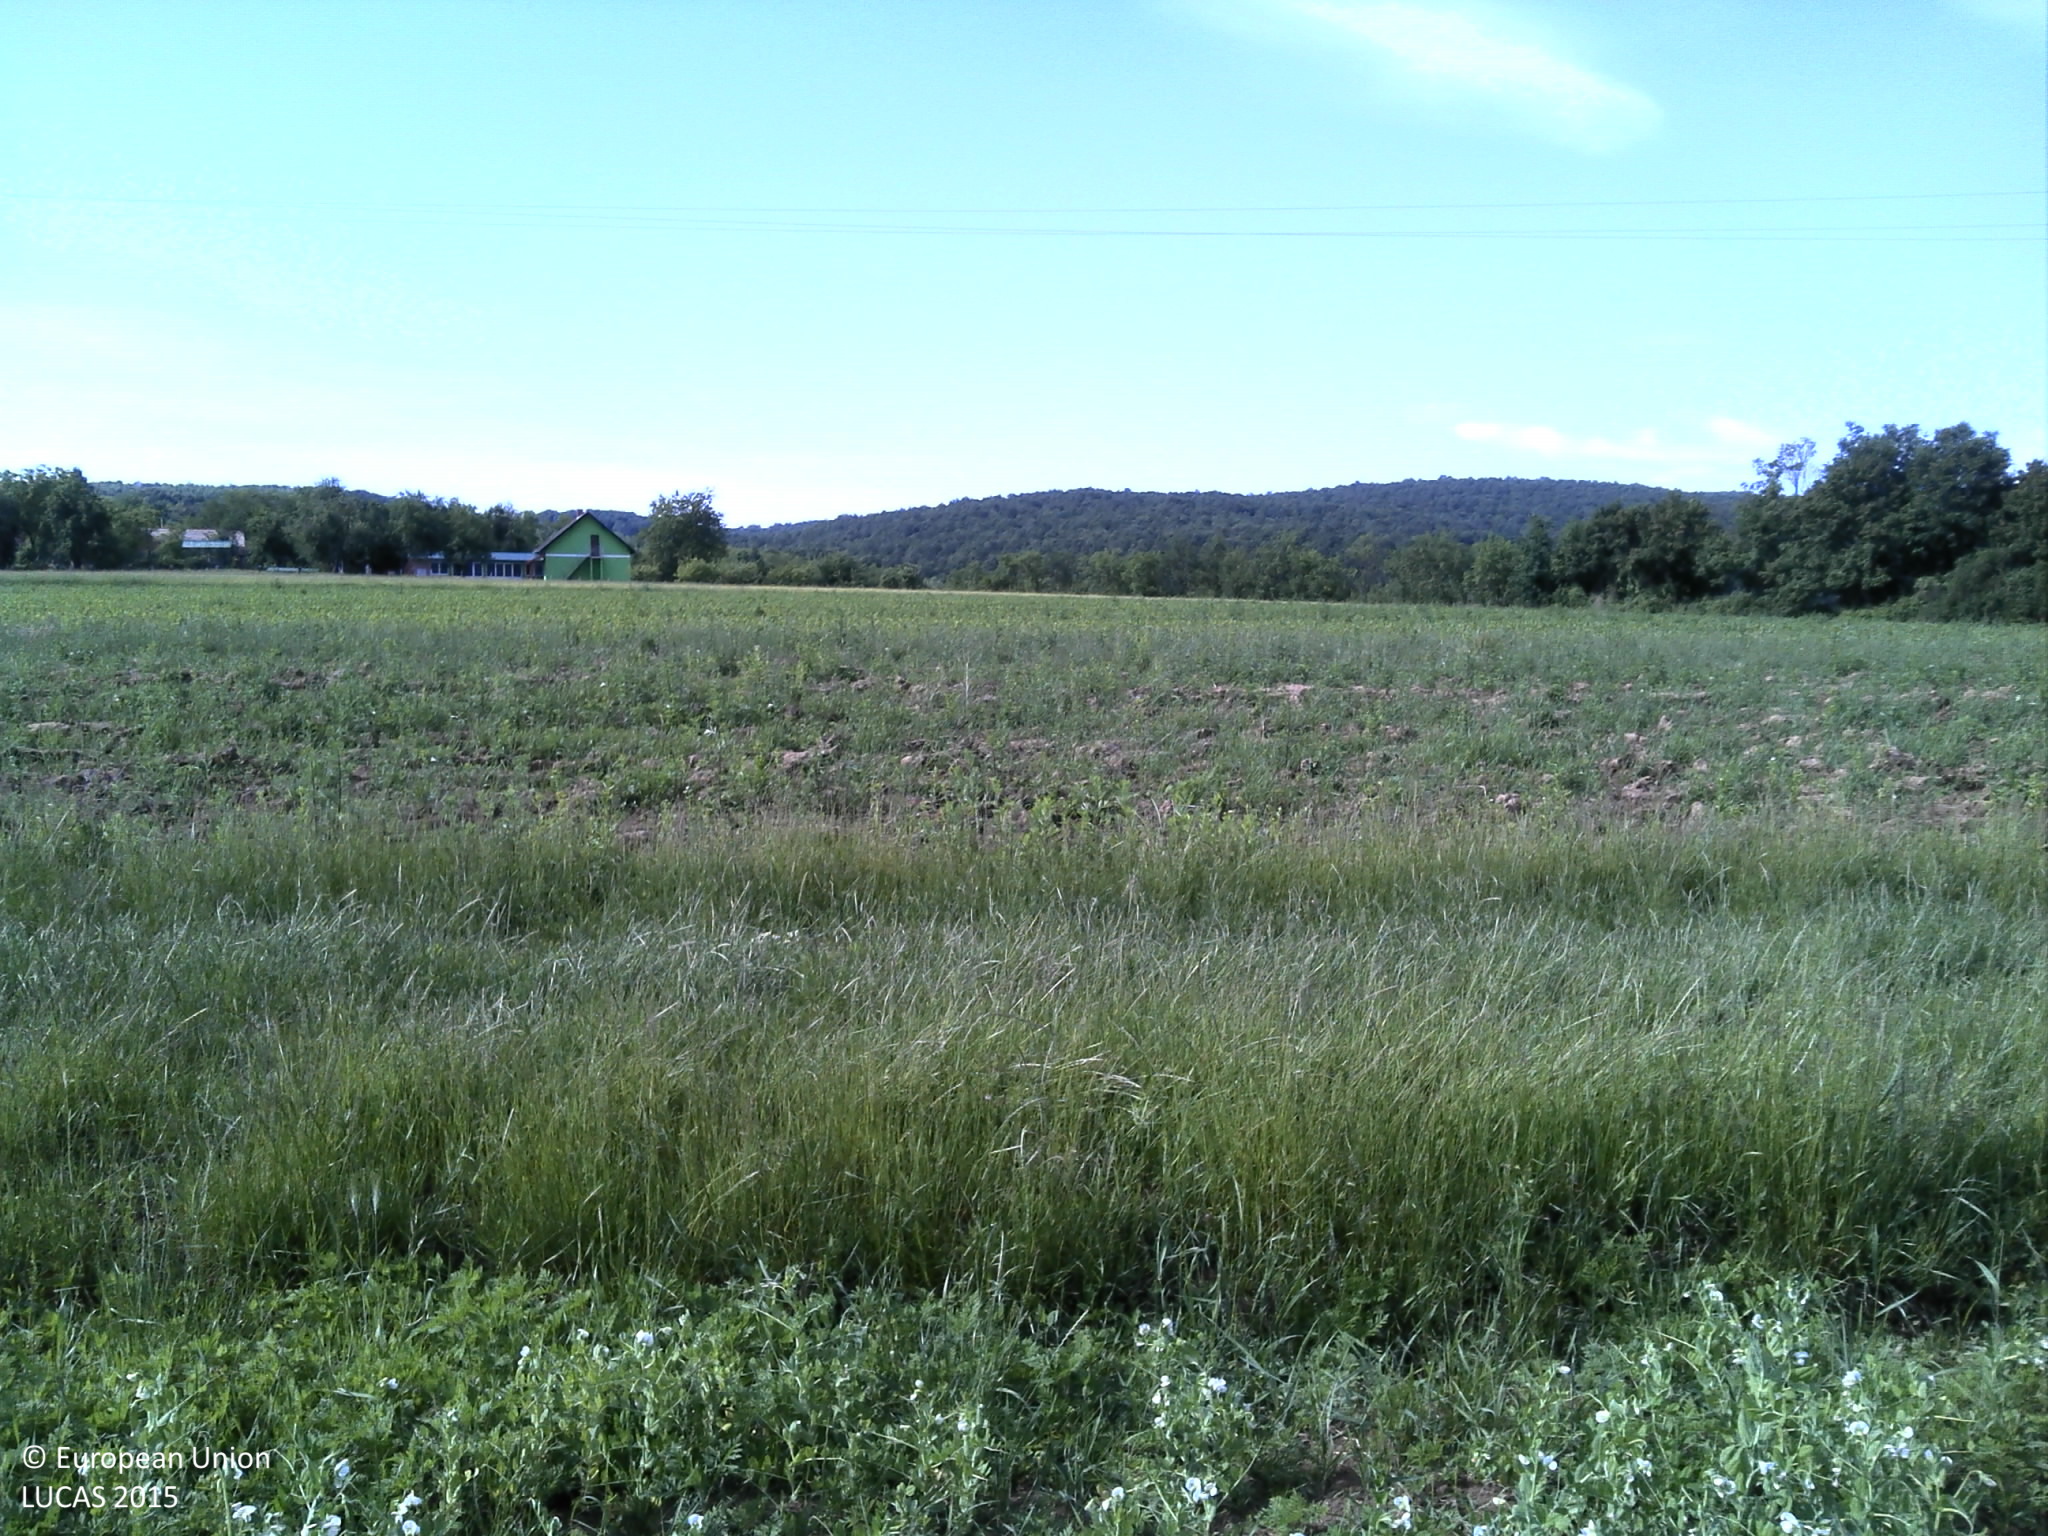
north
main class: Cropland
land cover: Dry pulses
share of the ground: 50 - 75 %
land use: Agriculture (excluding fallow land and kitchen gardens)
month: May
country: HR
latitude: 45.3609
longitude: 18.0333
